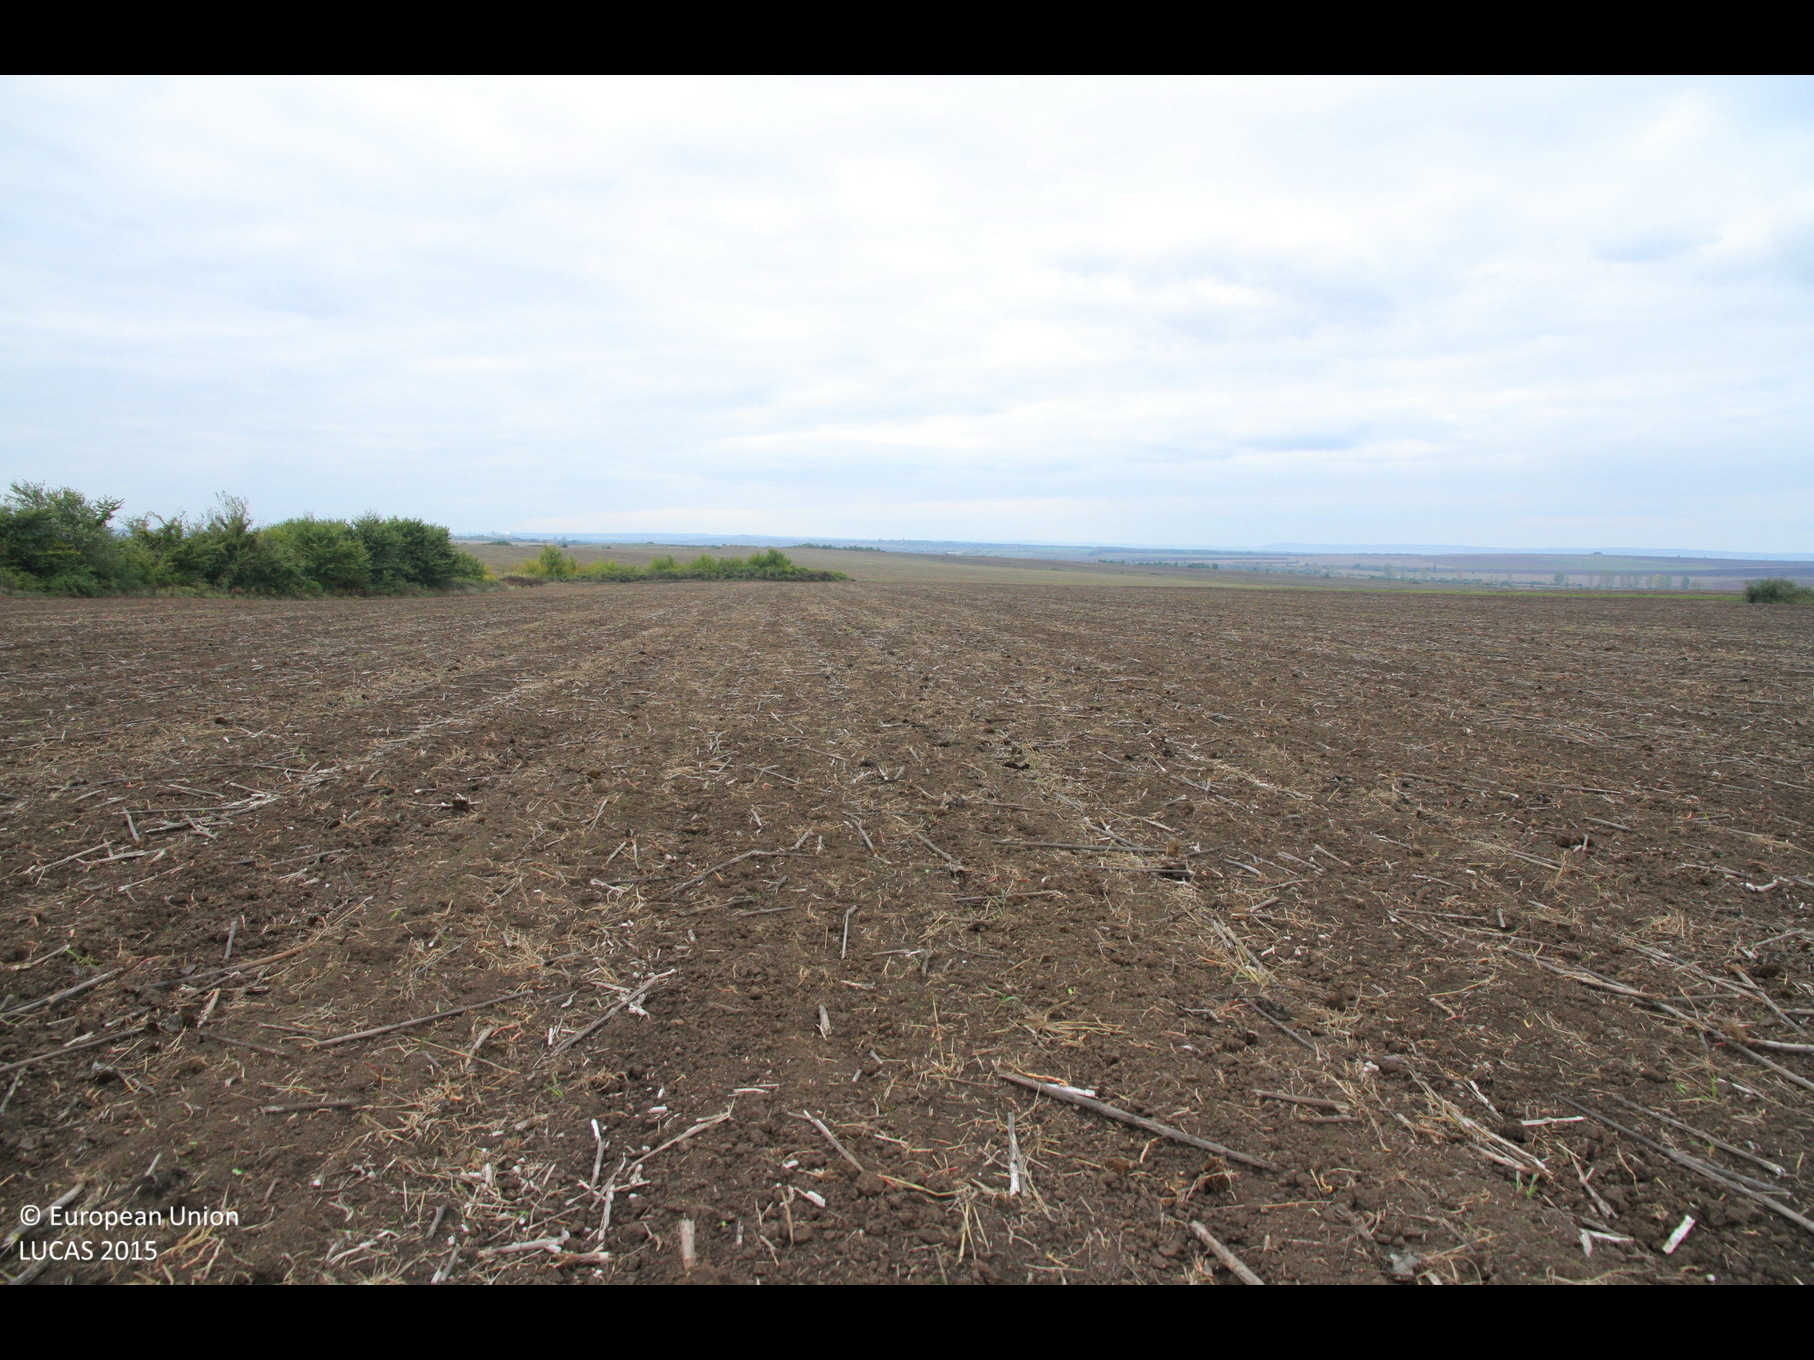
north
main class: Cropland
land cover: Sunflower
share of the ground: < 10 %
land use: Agriculture (excluding fallow land and kitchen gardens)
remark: Harvested field
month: October
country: BG
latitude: 43.2534
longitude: 27.0775
